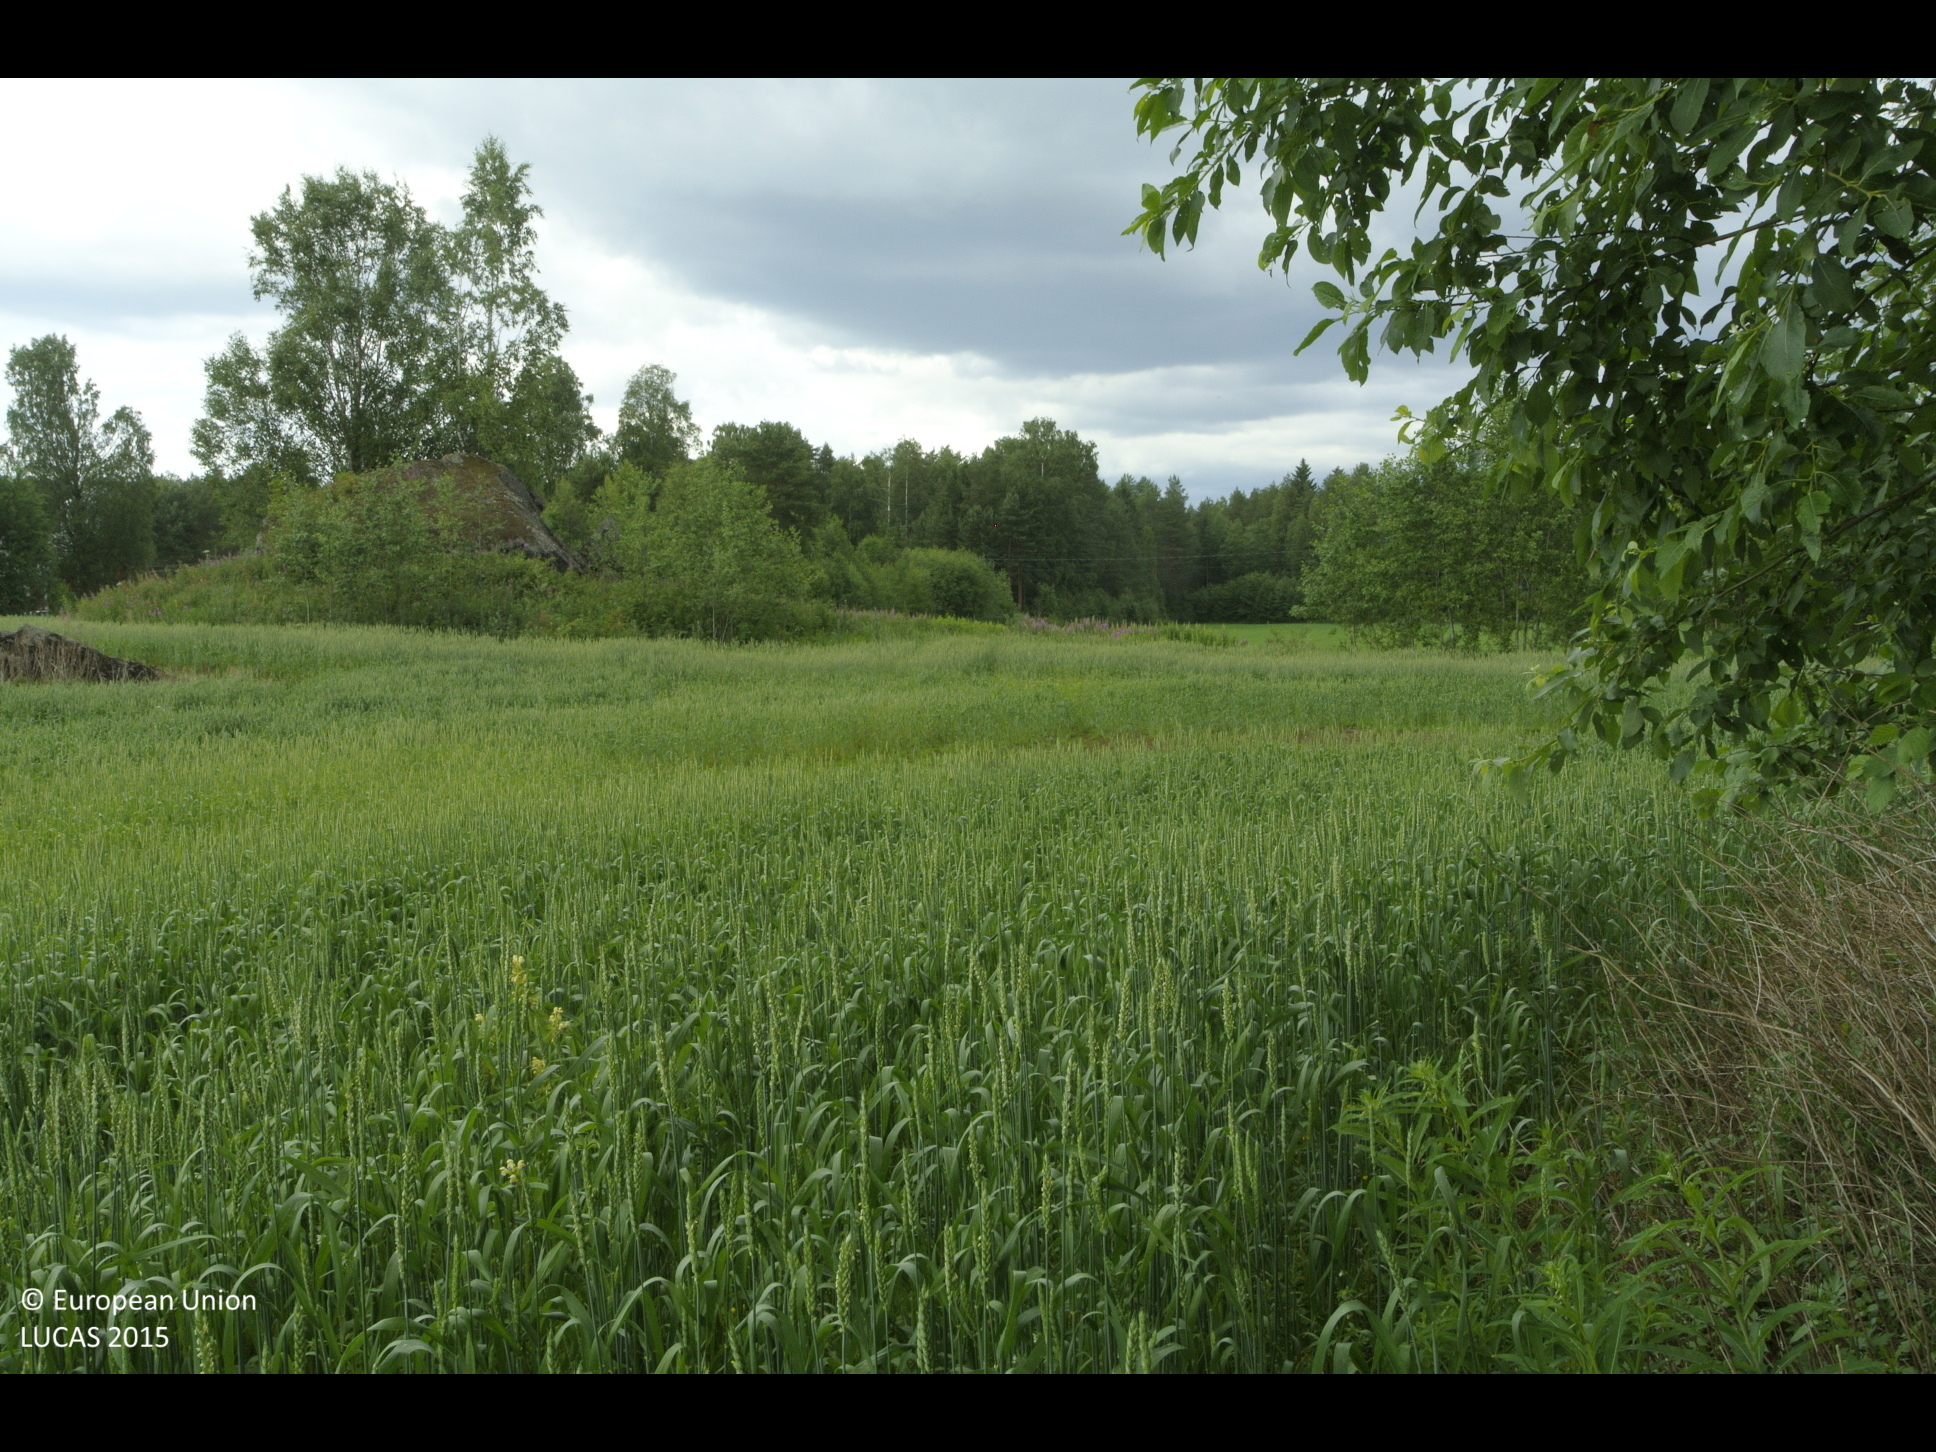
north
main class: Cropland
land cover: Common wheat
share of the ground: > 75 %
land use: Agriculture (excluding fallow land and kitchen gardens)
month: July
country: FI
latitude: 61.3170
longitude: 25.7237
